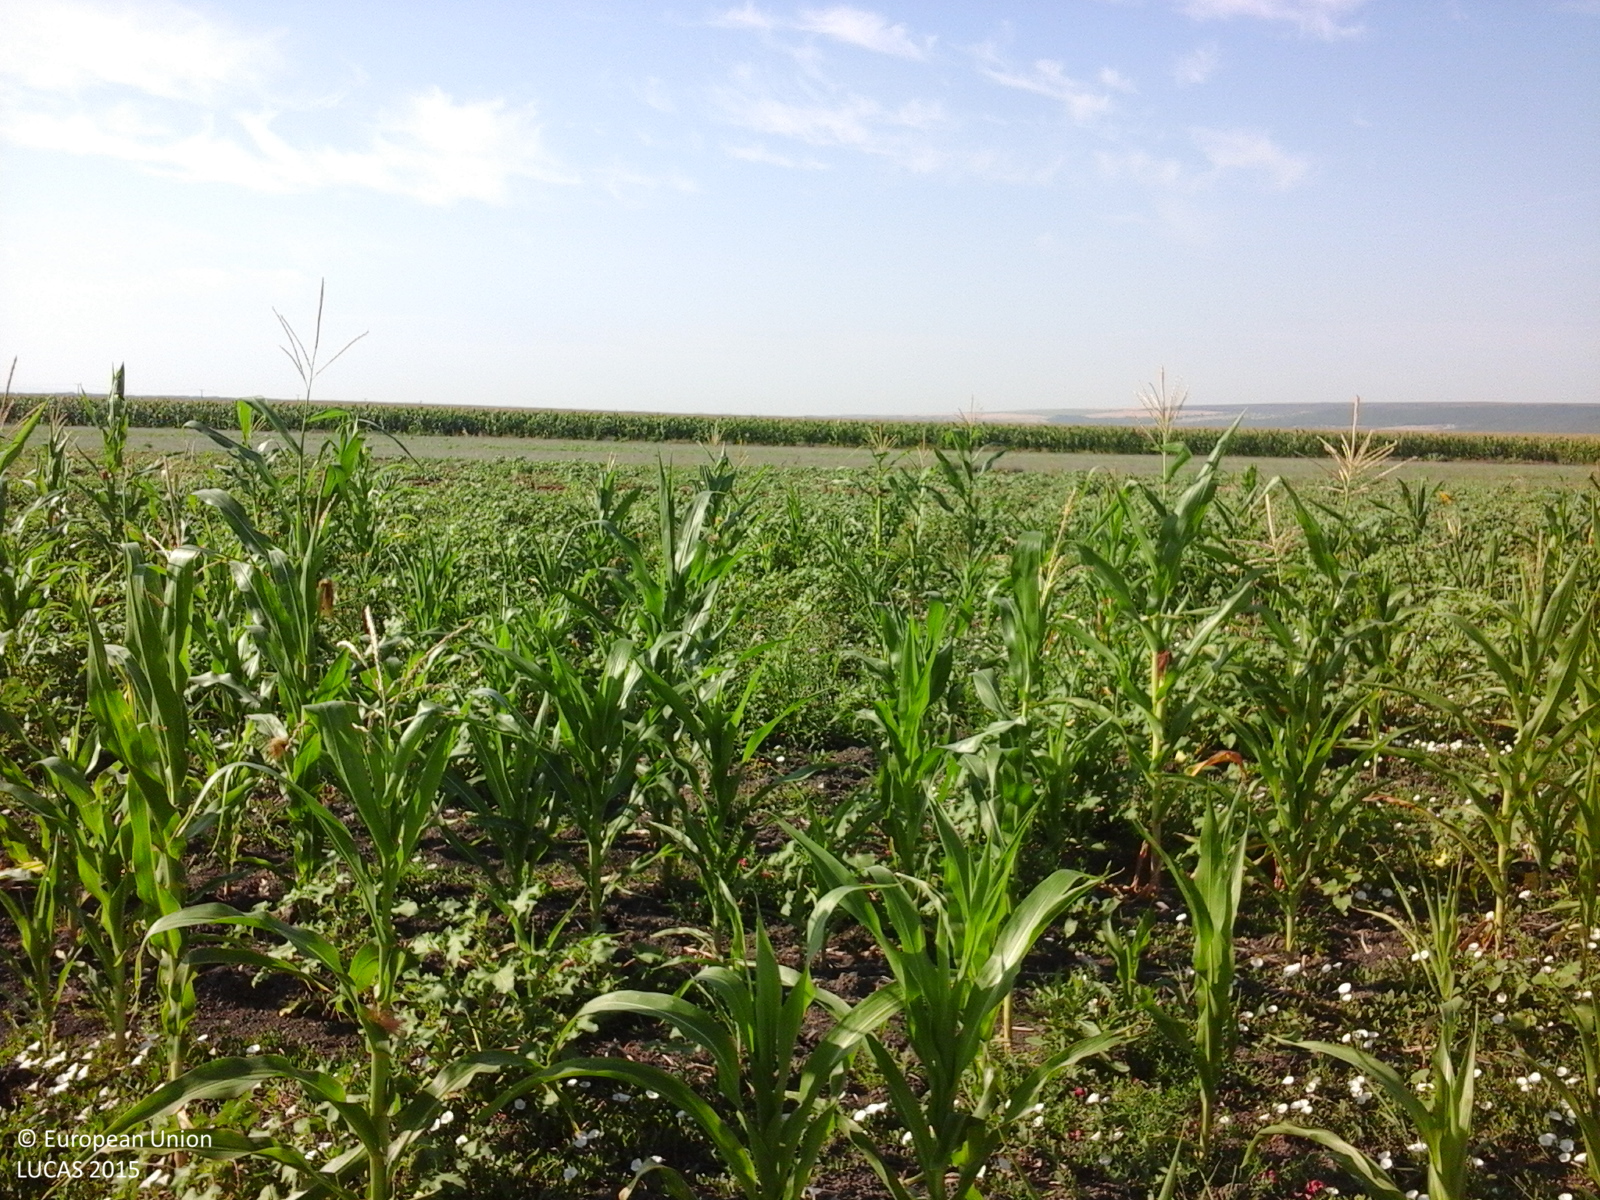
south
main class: Cropland
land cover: Maize
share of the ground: 50 - 75 %
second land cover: Spontaneously vegetated surfaces
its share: 25 - 50 %
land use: Agriculture (excluding fallow land and kitchen gardens)
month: July
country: RO
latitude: 46.5444
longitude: 28.1947
